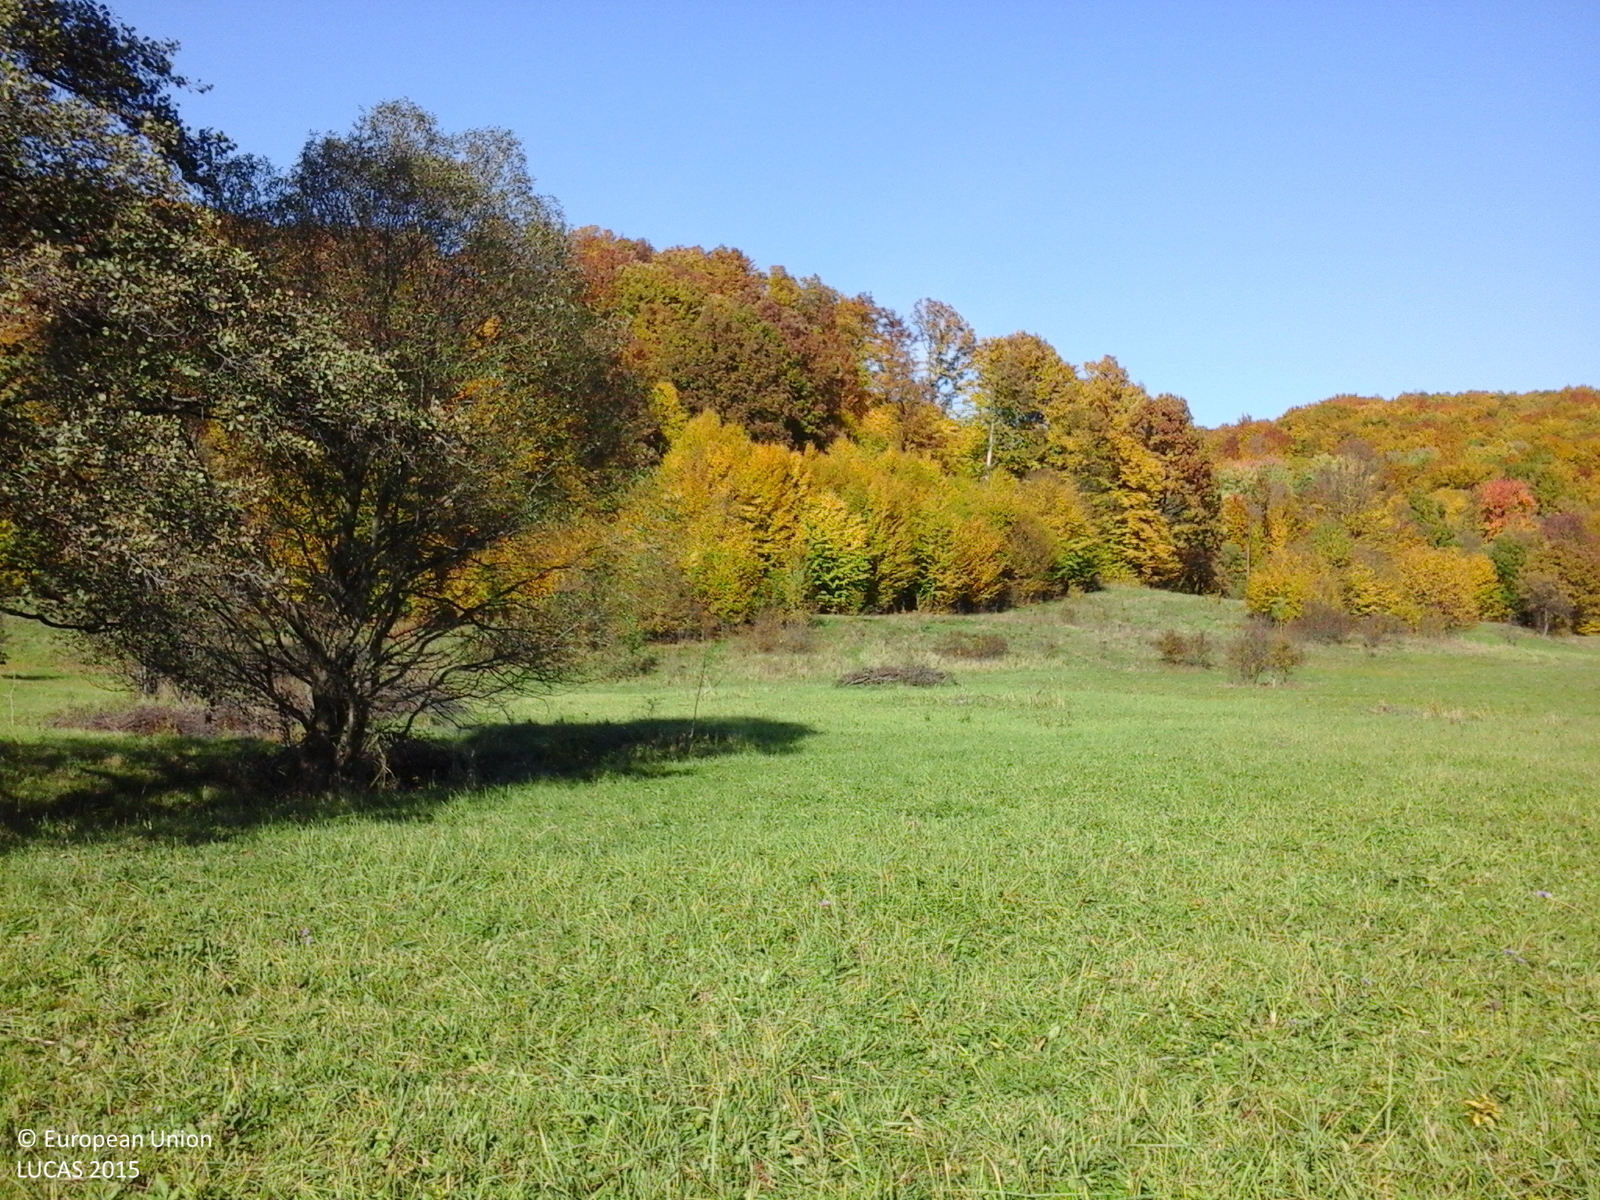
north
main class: Grassland
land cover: Grassland without tree/shrub cover
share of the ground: > 75 %
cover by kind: herbaceous plants 100 %
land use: Agriculture (excluding fallow land and kitchen gardens)
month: October
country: RO
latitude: 46.0511
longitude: 26.9575
